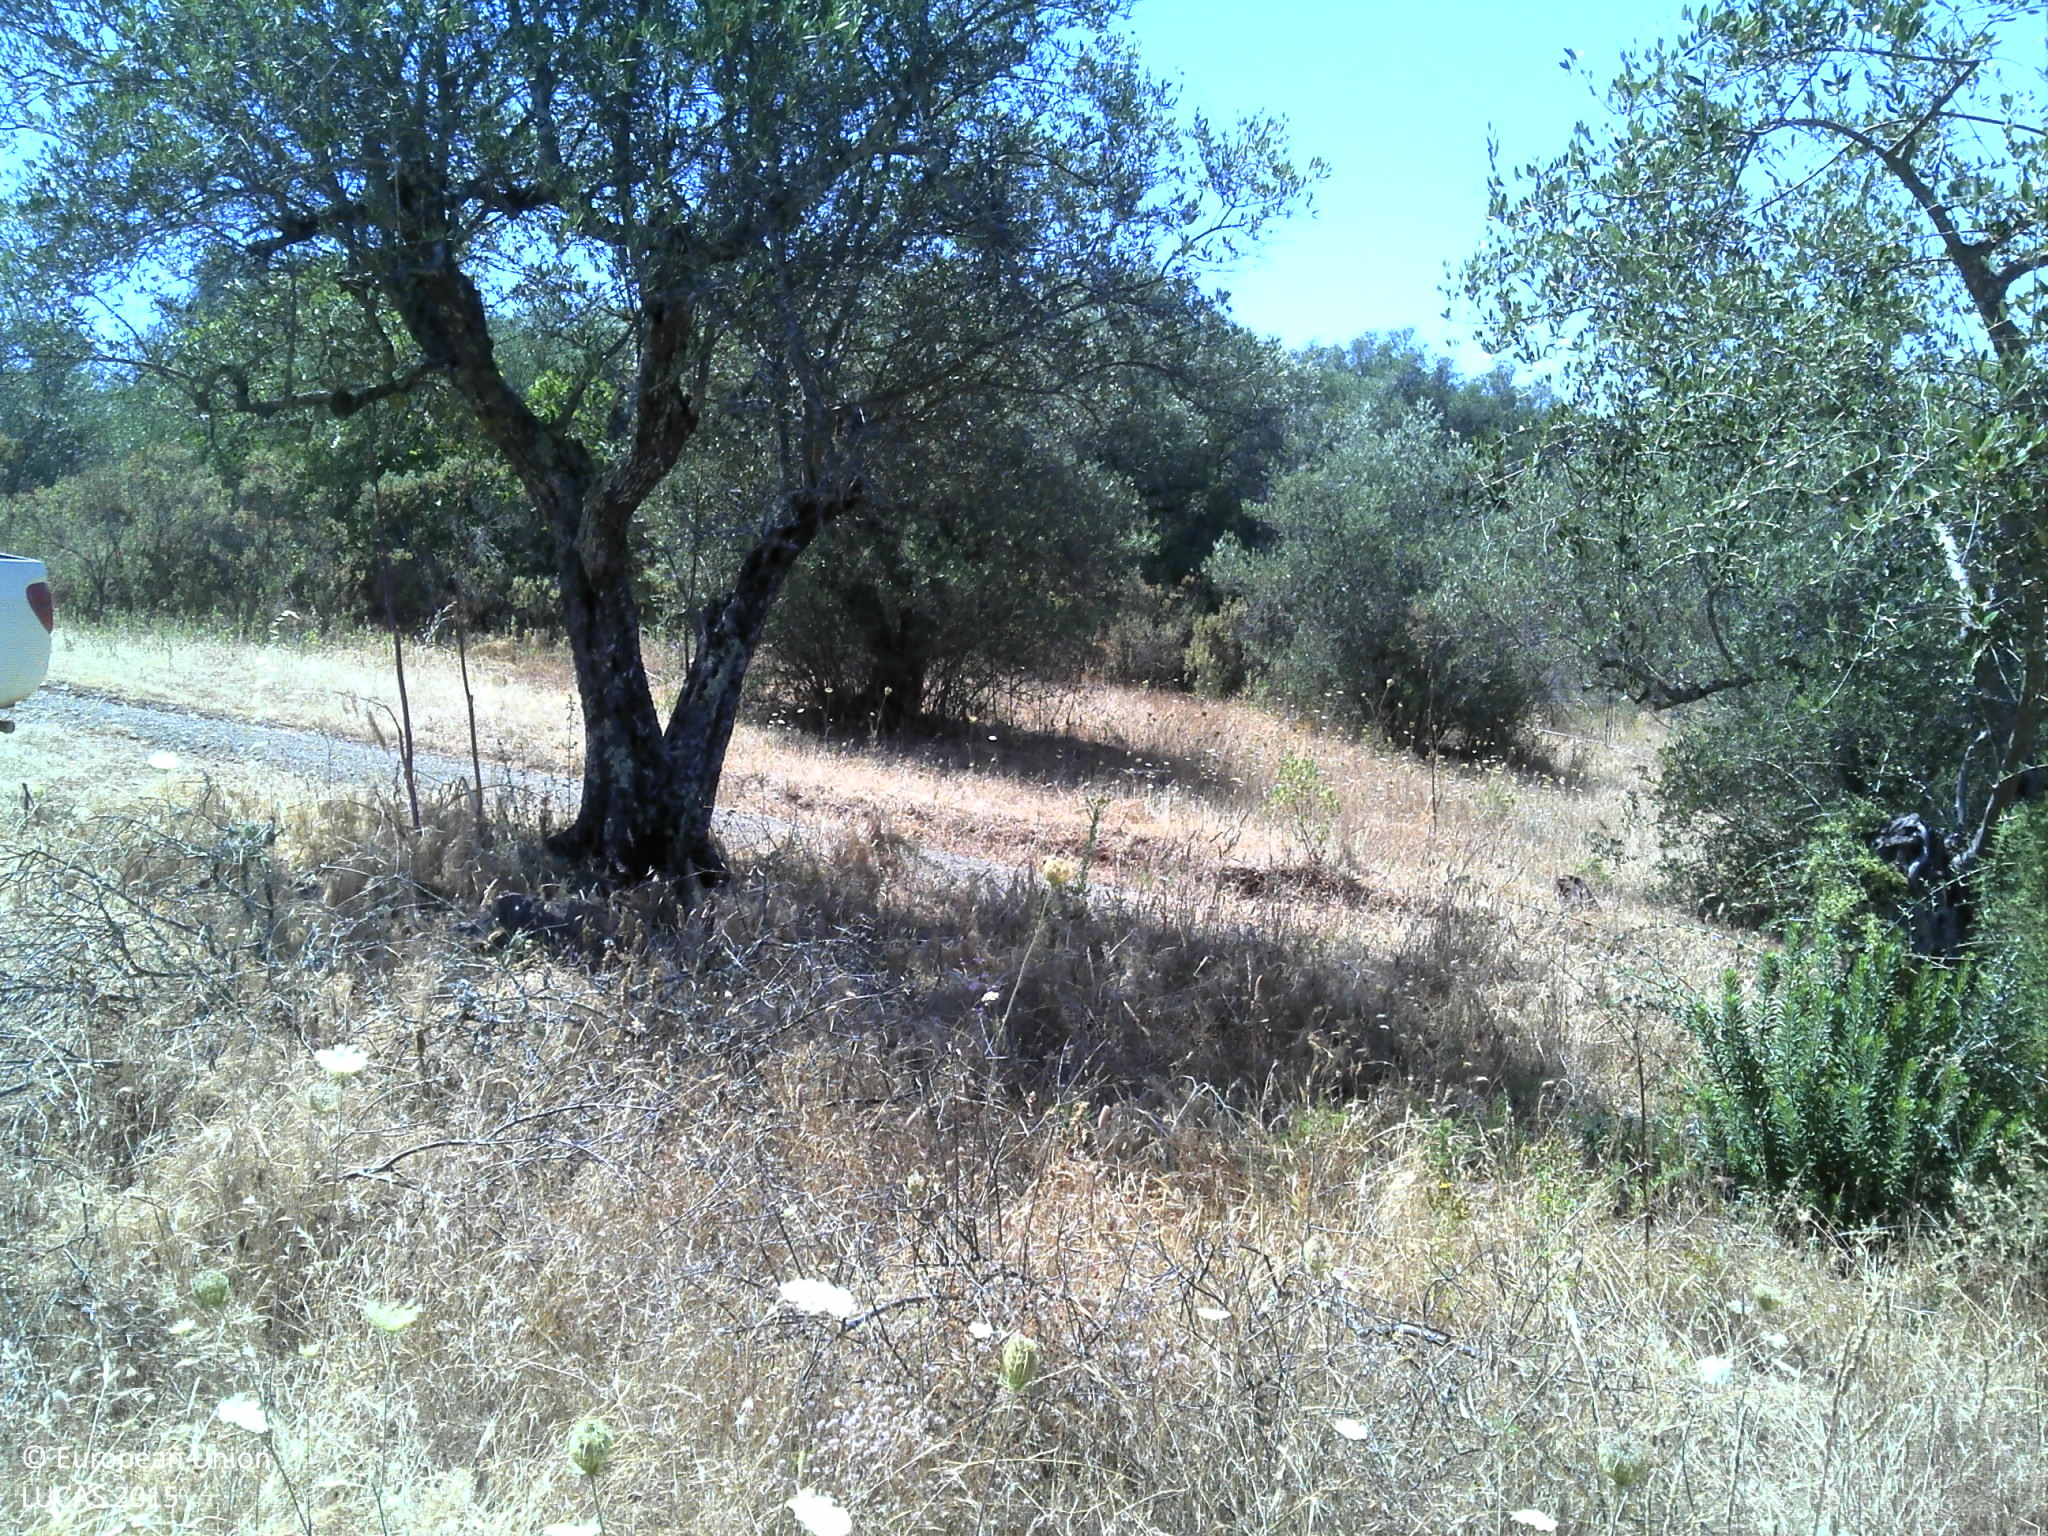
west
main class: Cropland
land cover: Olive groves
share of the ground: 50 - 75 %
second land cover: Grassland without tree/shrub cover
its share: 25 - 50 %
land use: Abandoned areas
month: June
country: PT
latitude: 37.9637
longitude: -7.2807
